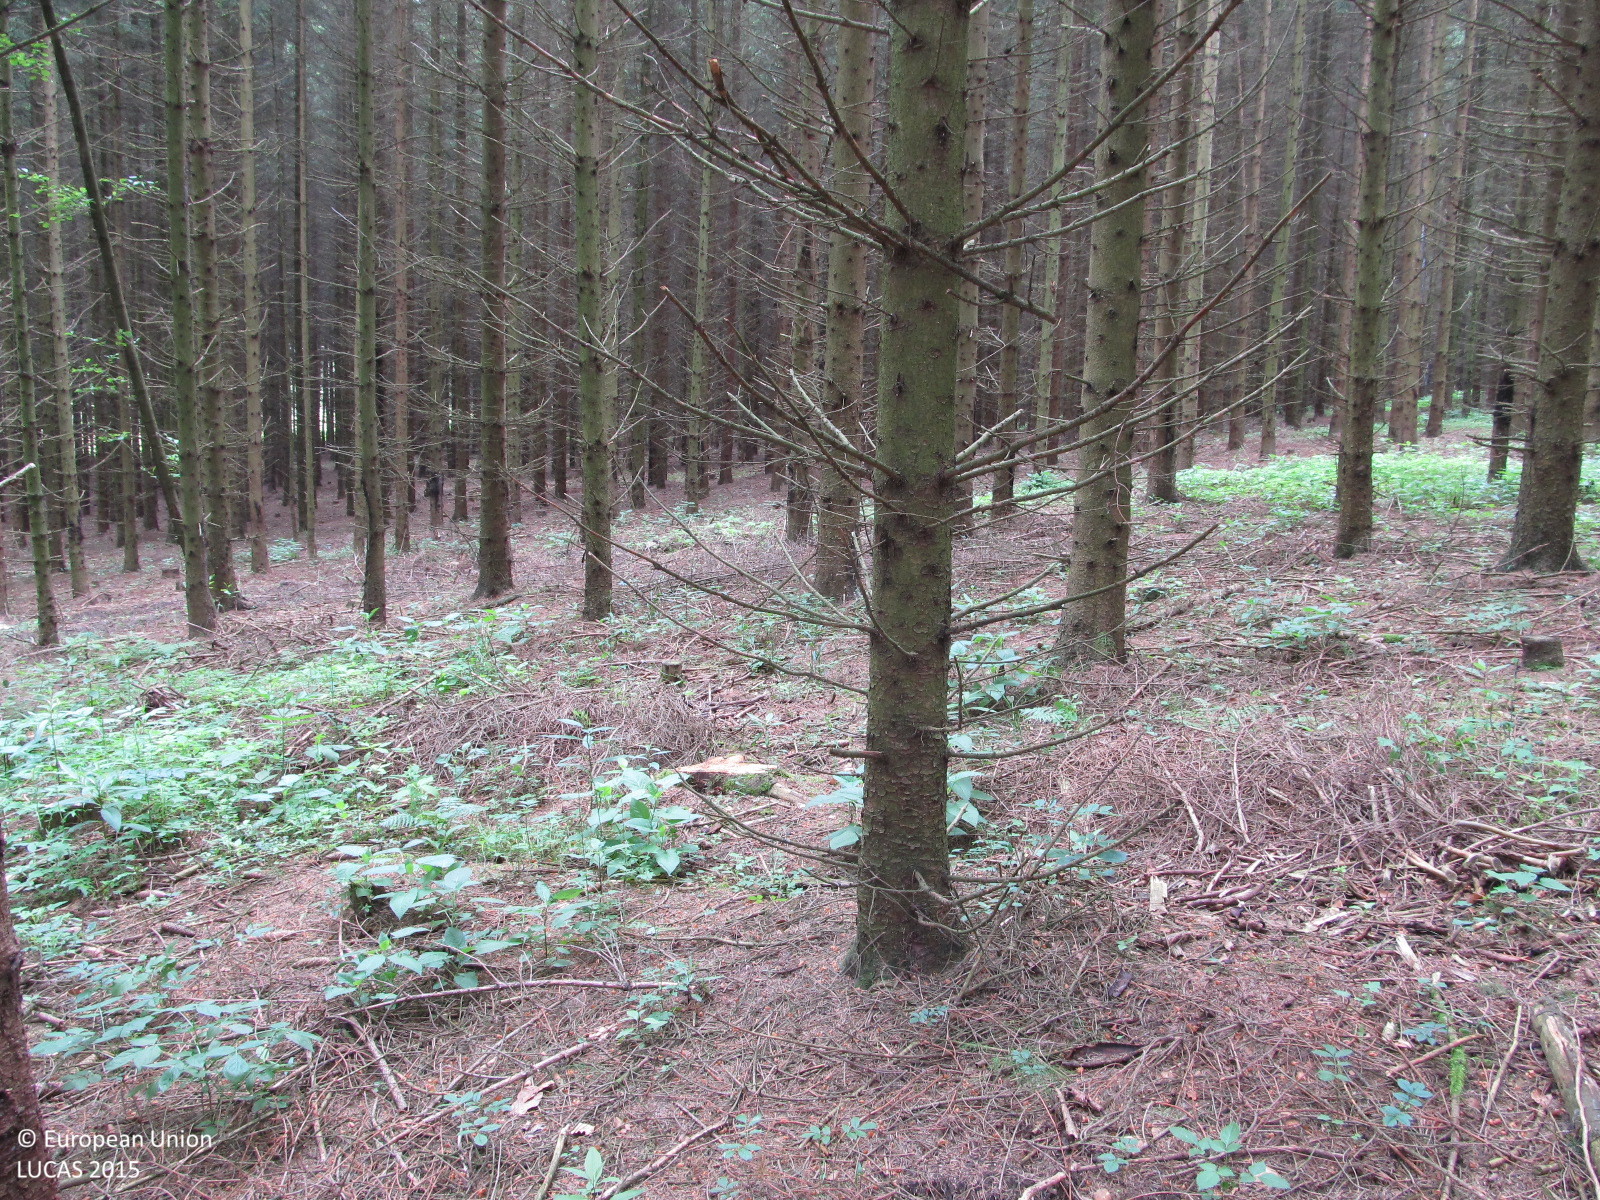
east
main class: Woodland
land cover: Spruce dominated coniferous woodland
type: hemiboreal forest and nemoral coniferous forest and mixed broadleaved-coniferous forest
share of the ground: > 75 %
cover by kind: coniferous forest trees 80 %, unconsolidated bare surface 20 %
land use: Forestry
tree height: > 5 m
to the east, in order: Spruce dominated coniferous woodland; Tracks; Spruce dominated coniferous woodland; Tracks; Spruce dominated coniferous woodland; Grassland without tree/shrub cover; Fences; Maize
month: June
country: AT
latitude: 48.5776
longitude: 15.4108
